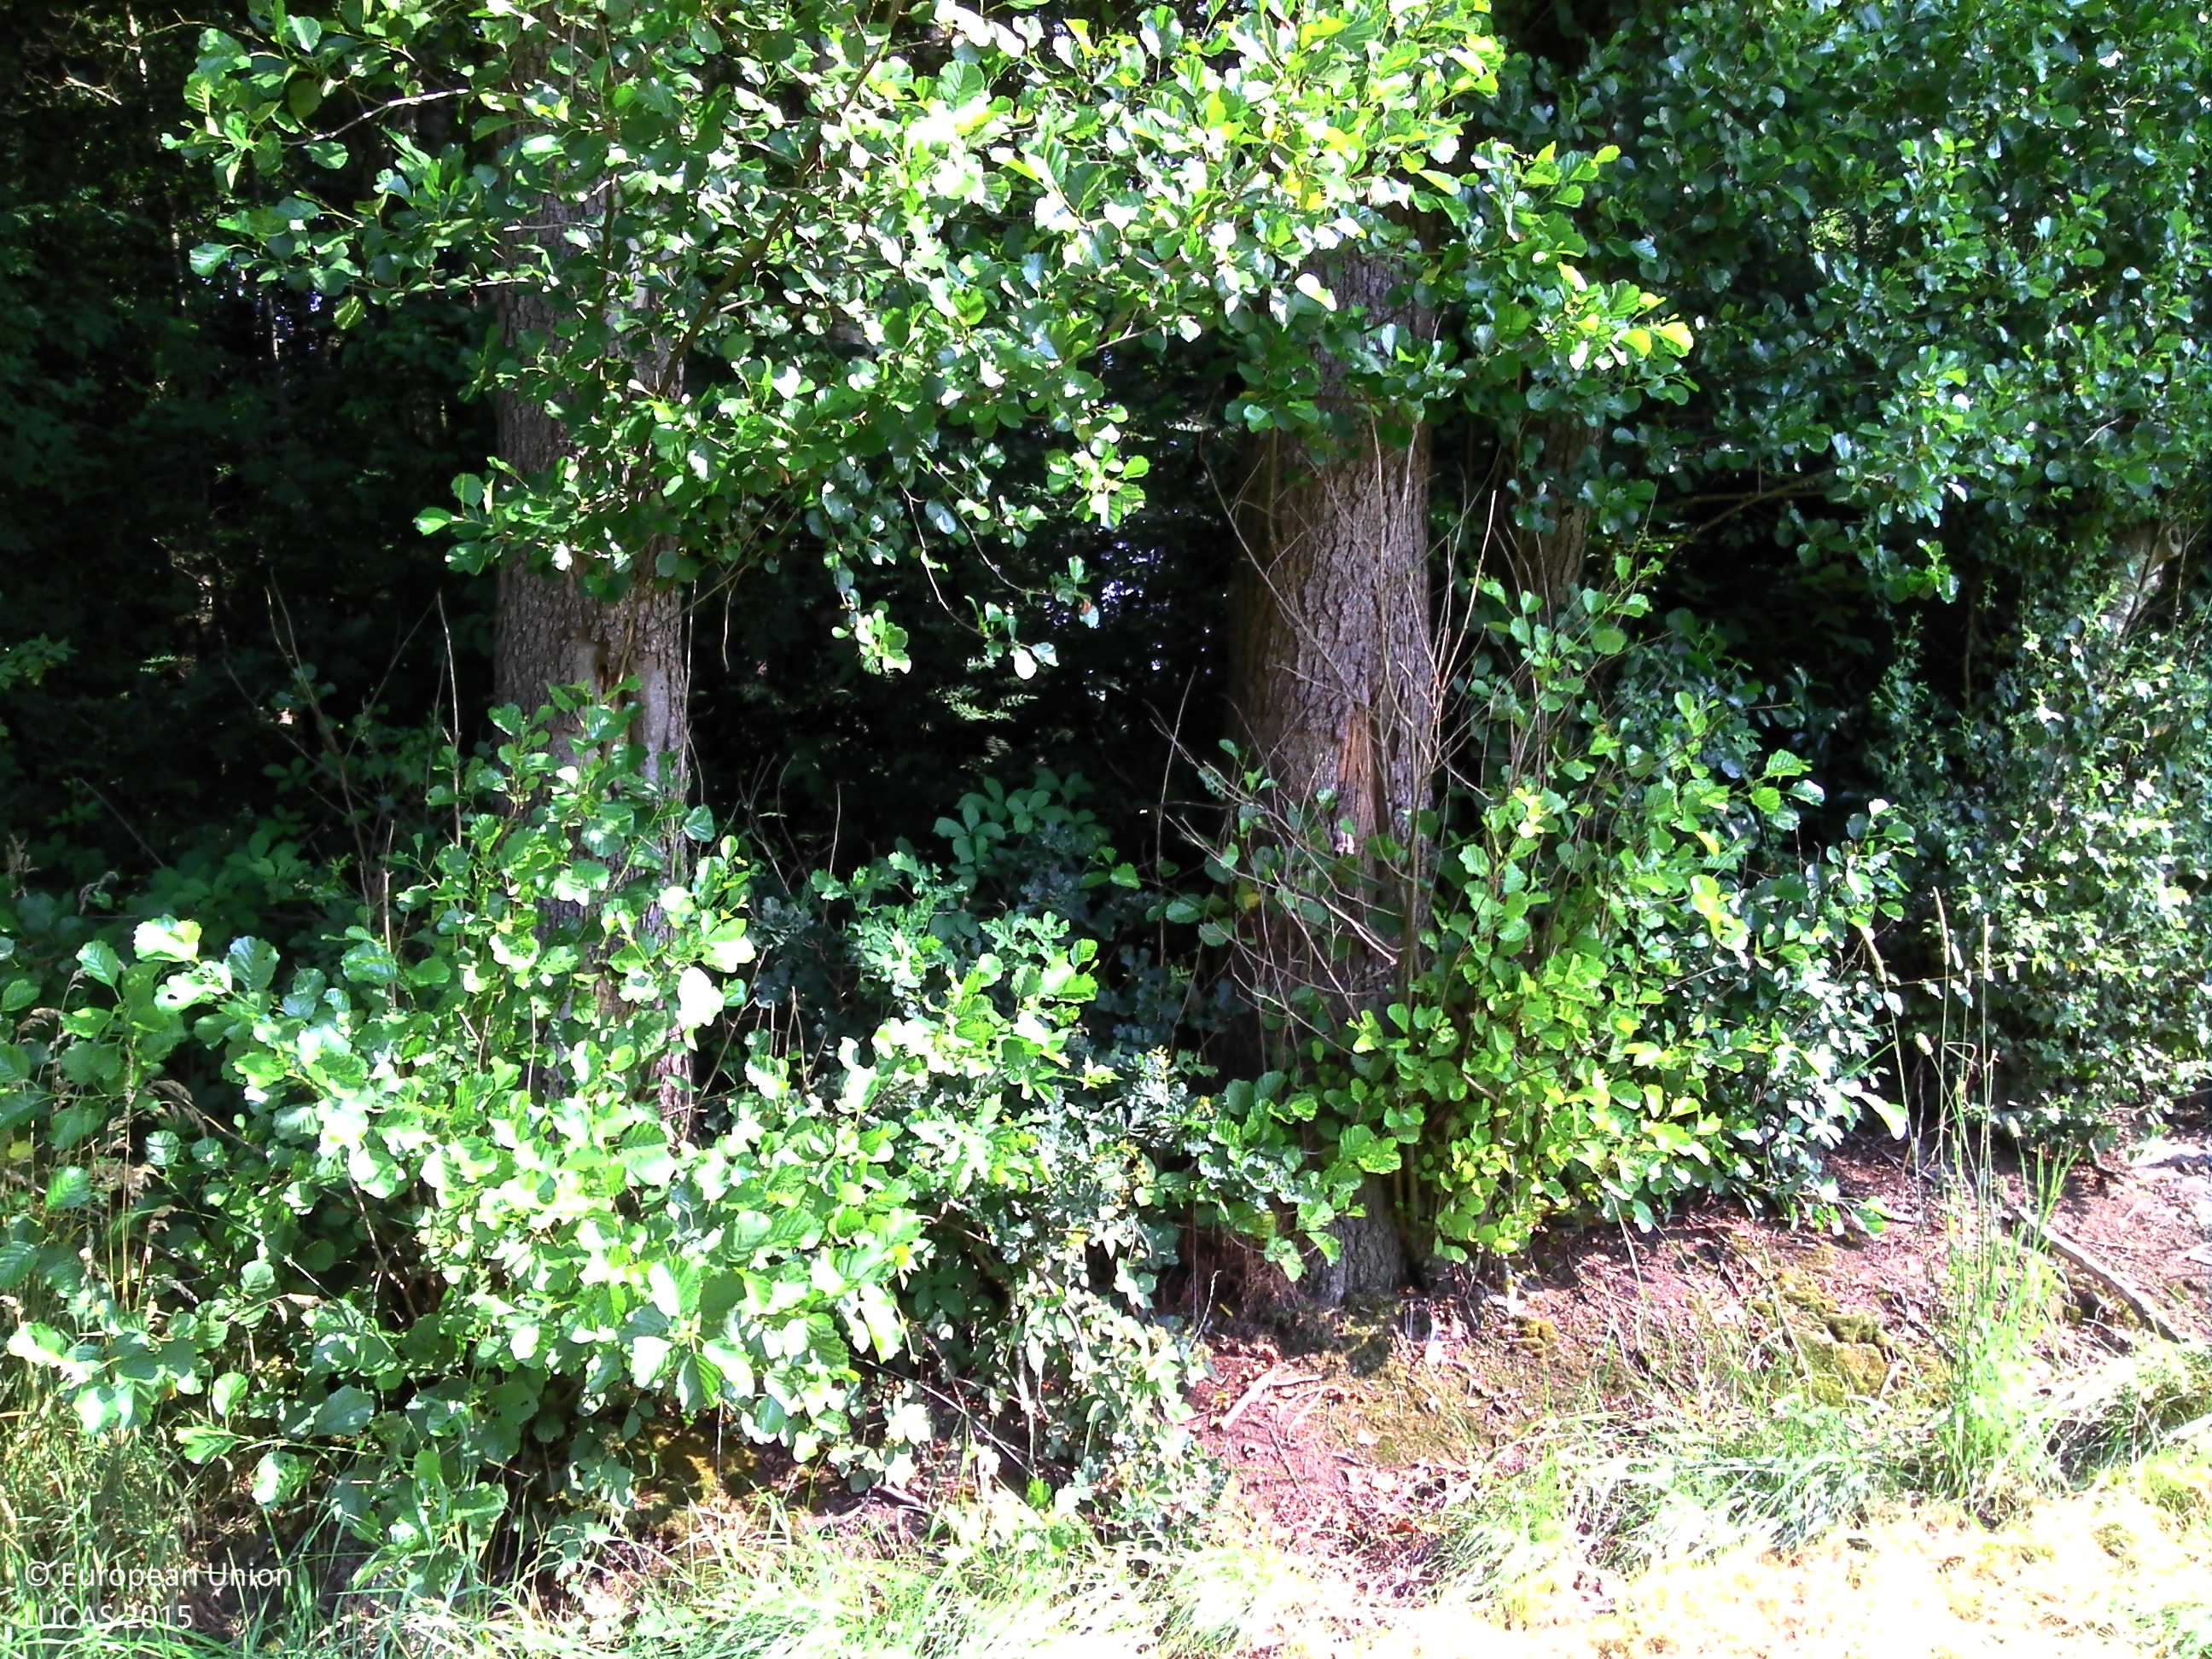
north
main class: Grassland
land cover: Grassland without tree/shrub cover
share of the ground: > 75 %
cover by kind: herbaceous plants 100 %
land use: Agriculture (excluding fallow land and kitchen gardens)
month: July
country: BE
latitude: 51.1039
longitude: 5.4994
